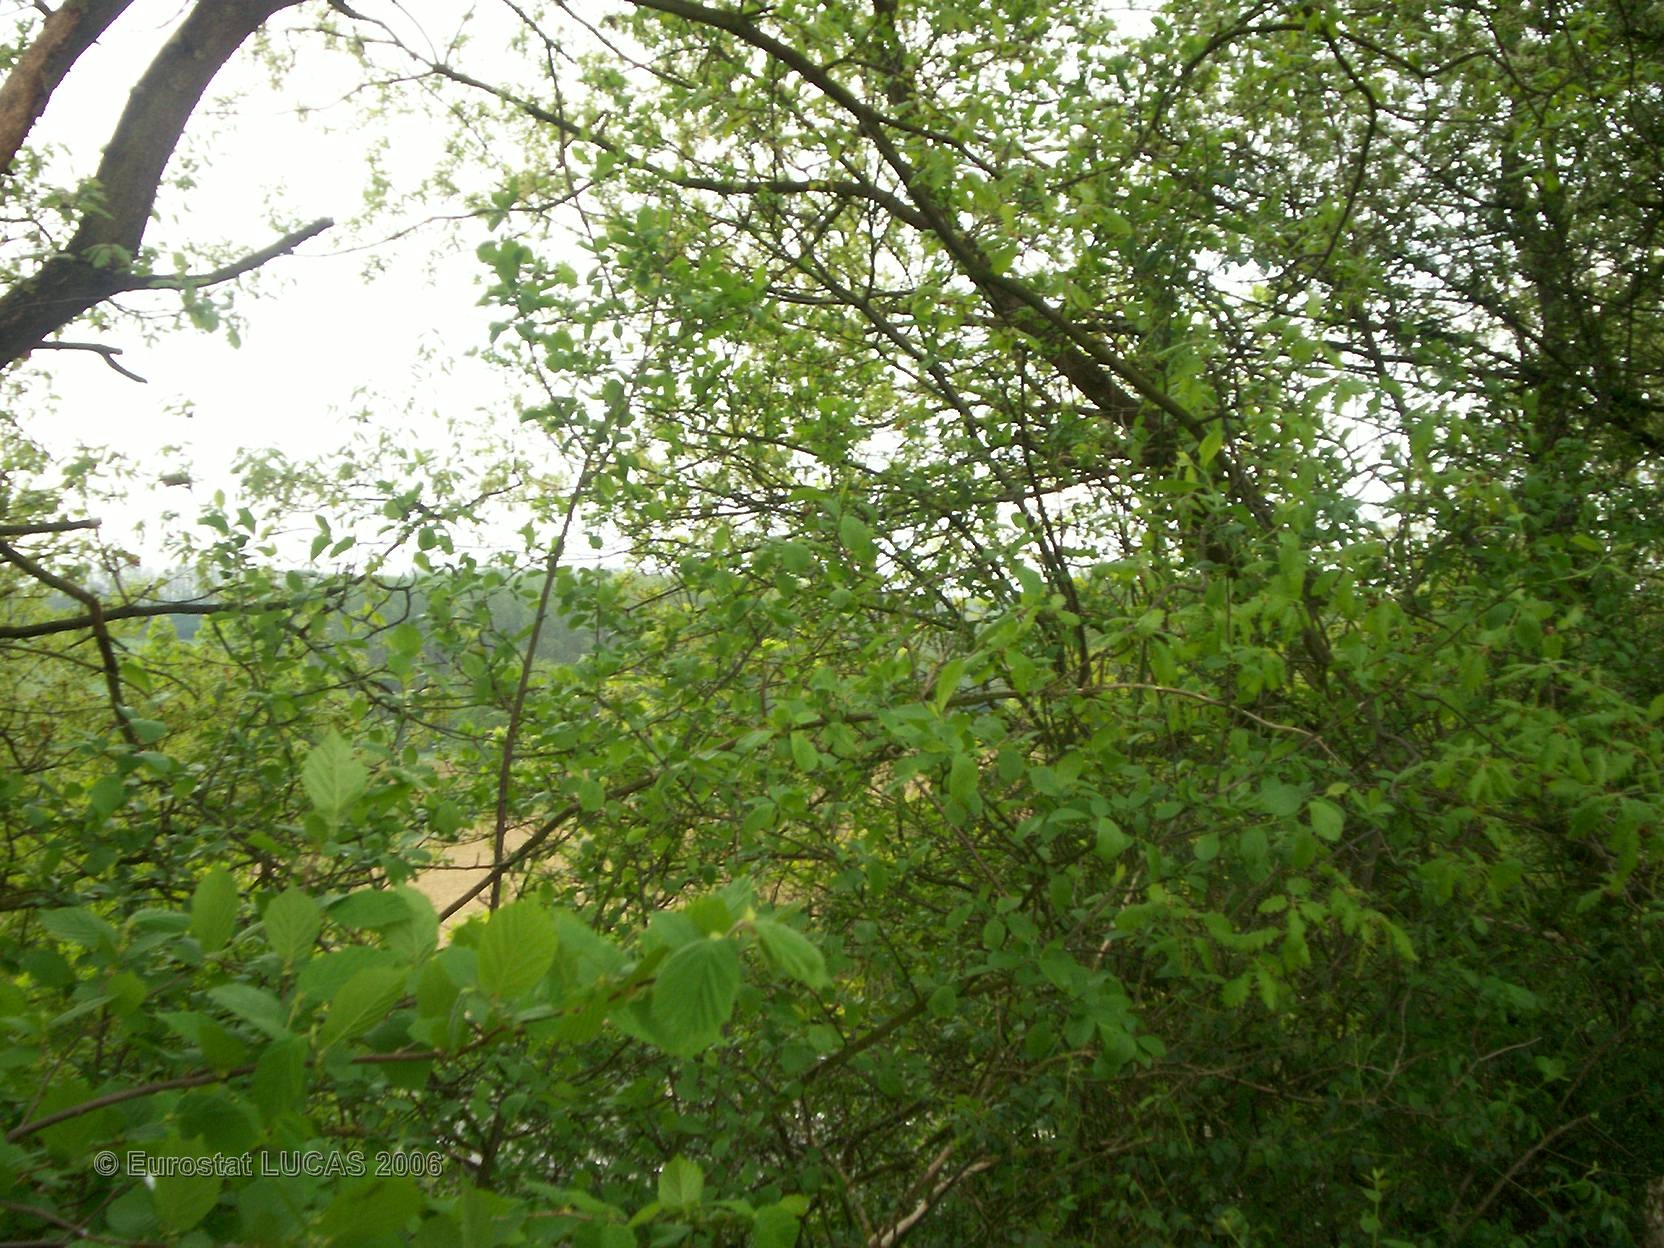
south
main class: Cropland
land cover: Maize
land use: Agriculture (excluding fallow land and kitchen gardens)
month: June
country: FR
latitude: 45.3599
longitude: 4.8343
